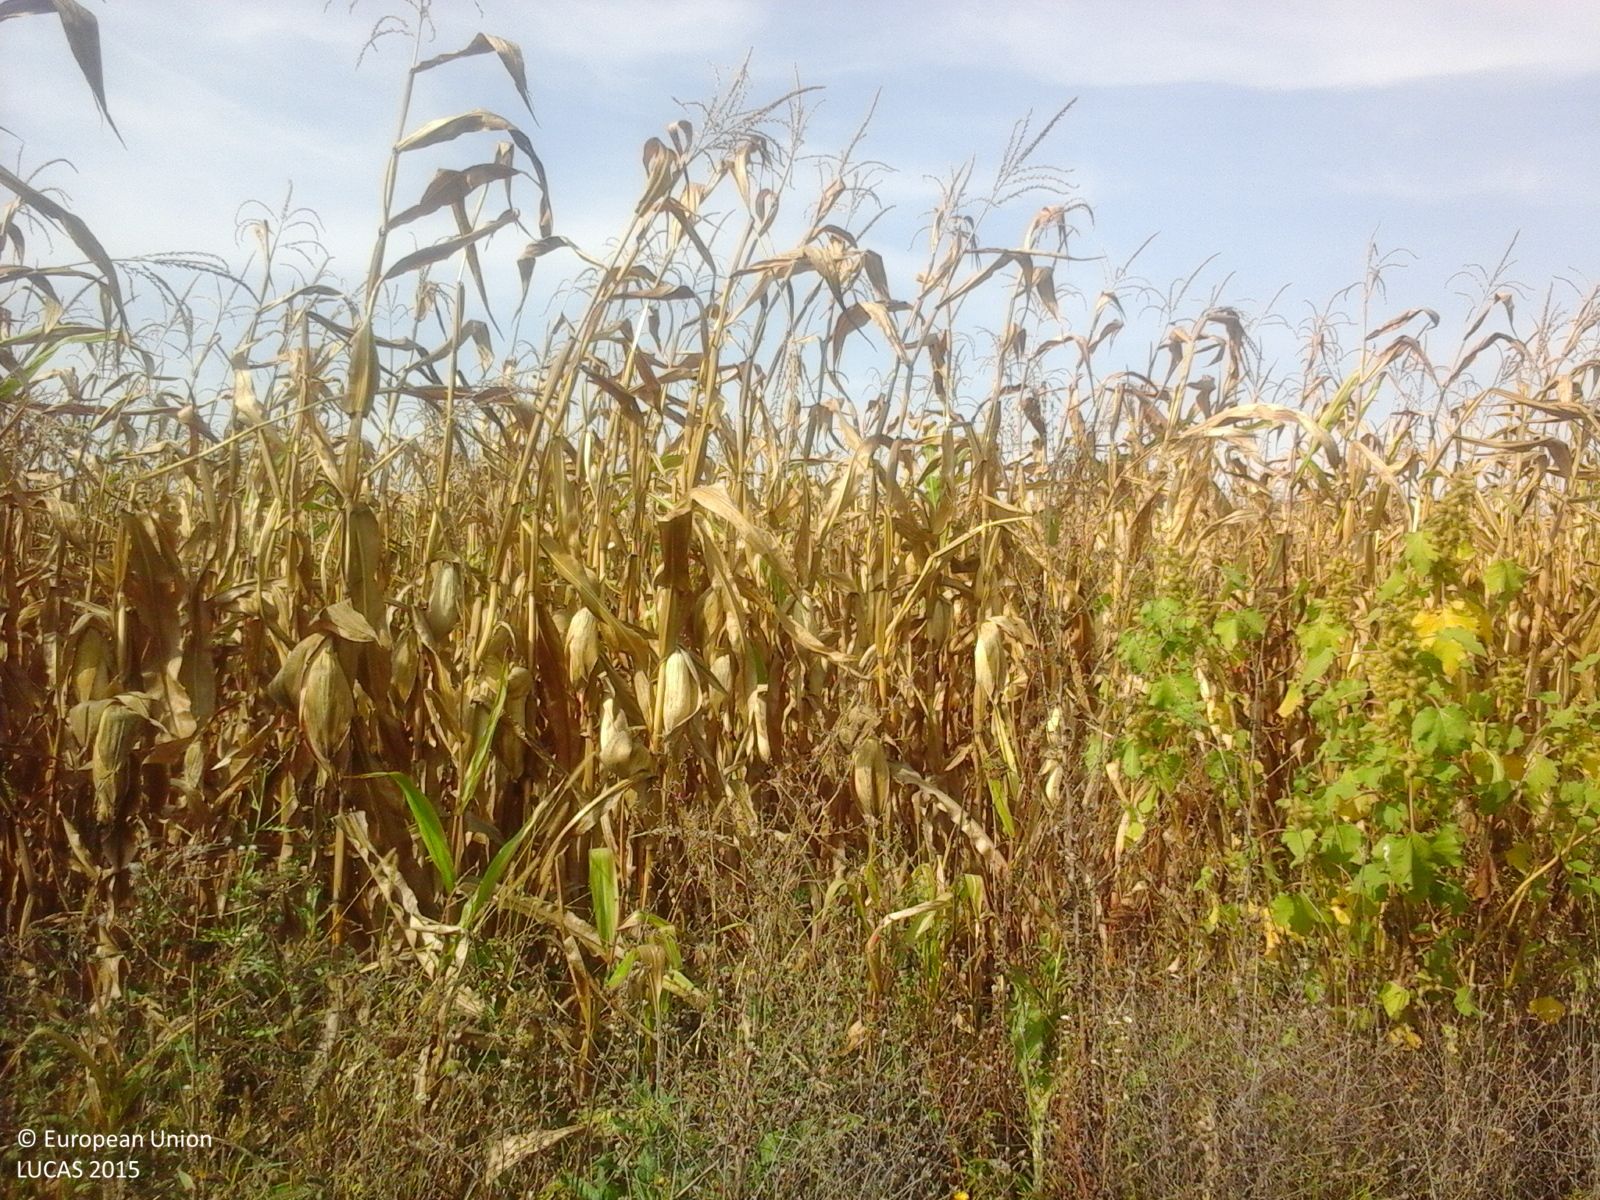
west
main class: Cropland
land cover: Maize
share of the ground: > 75 %
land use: Agriculture (excluding fallow land and kitchen gardens)
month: September
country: RO
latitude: 46.8615
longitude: 24.0502
